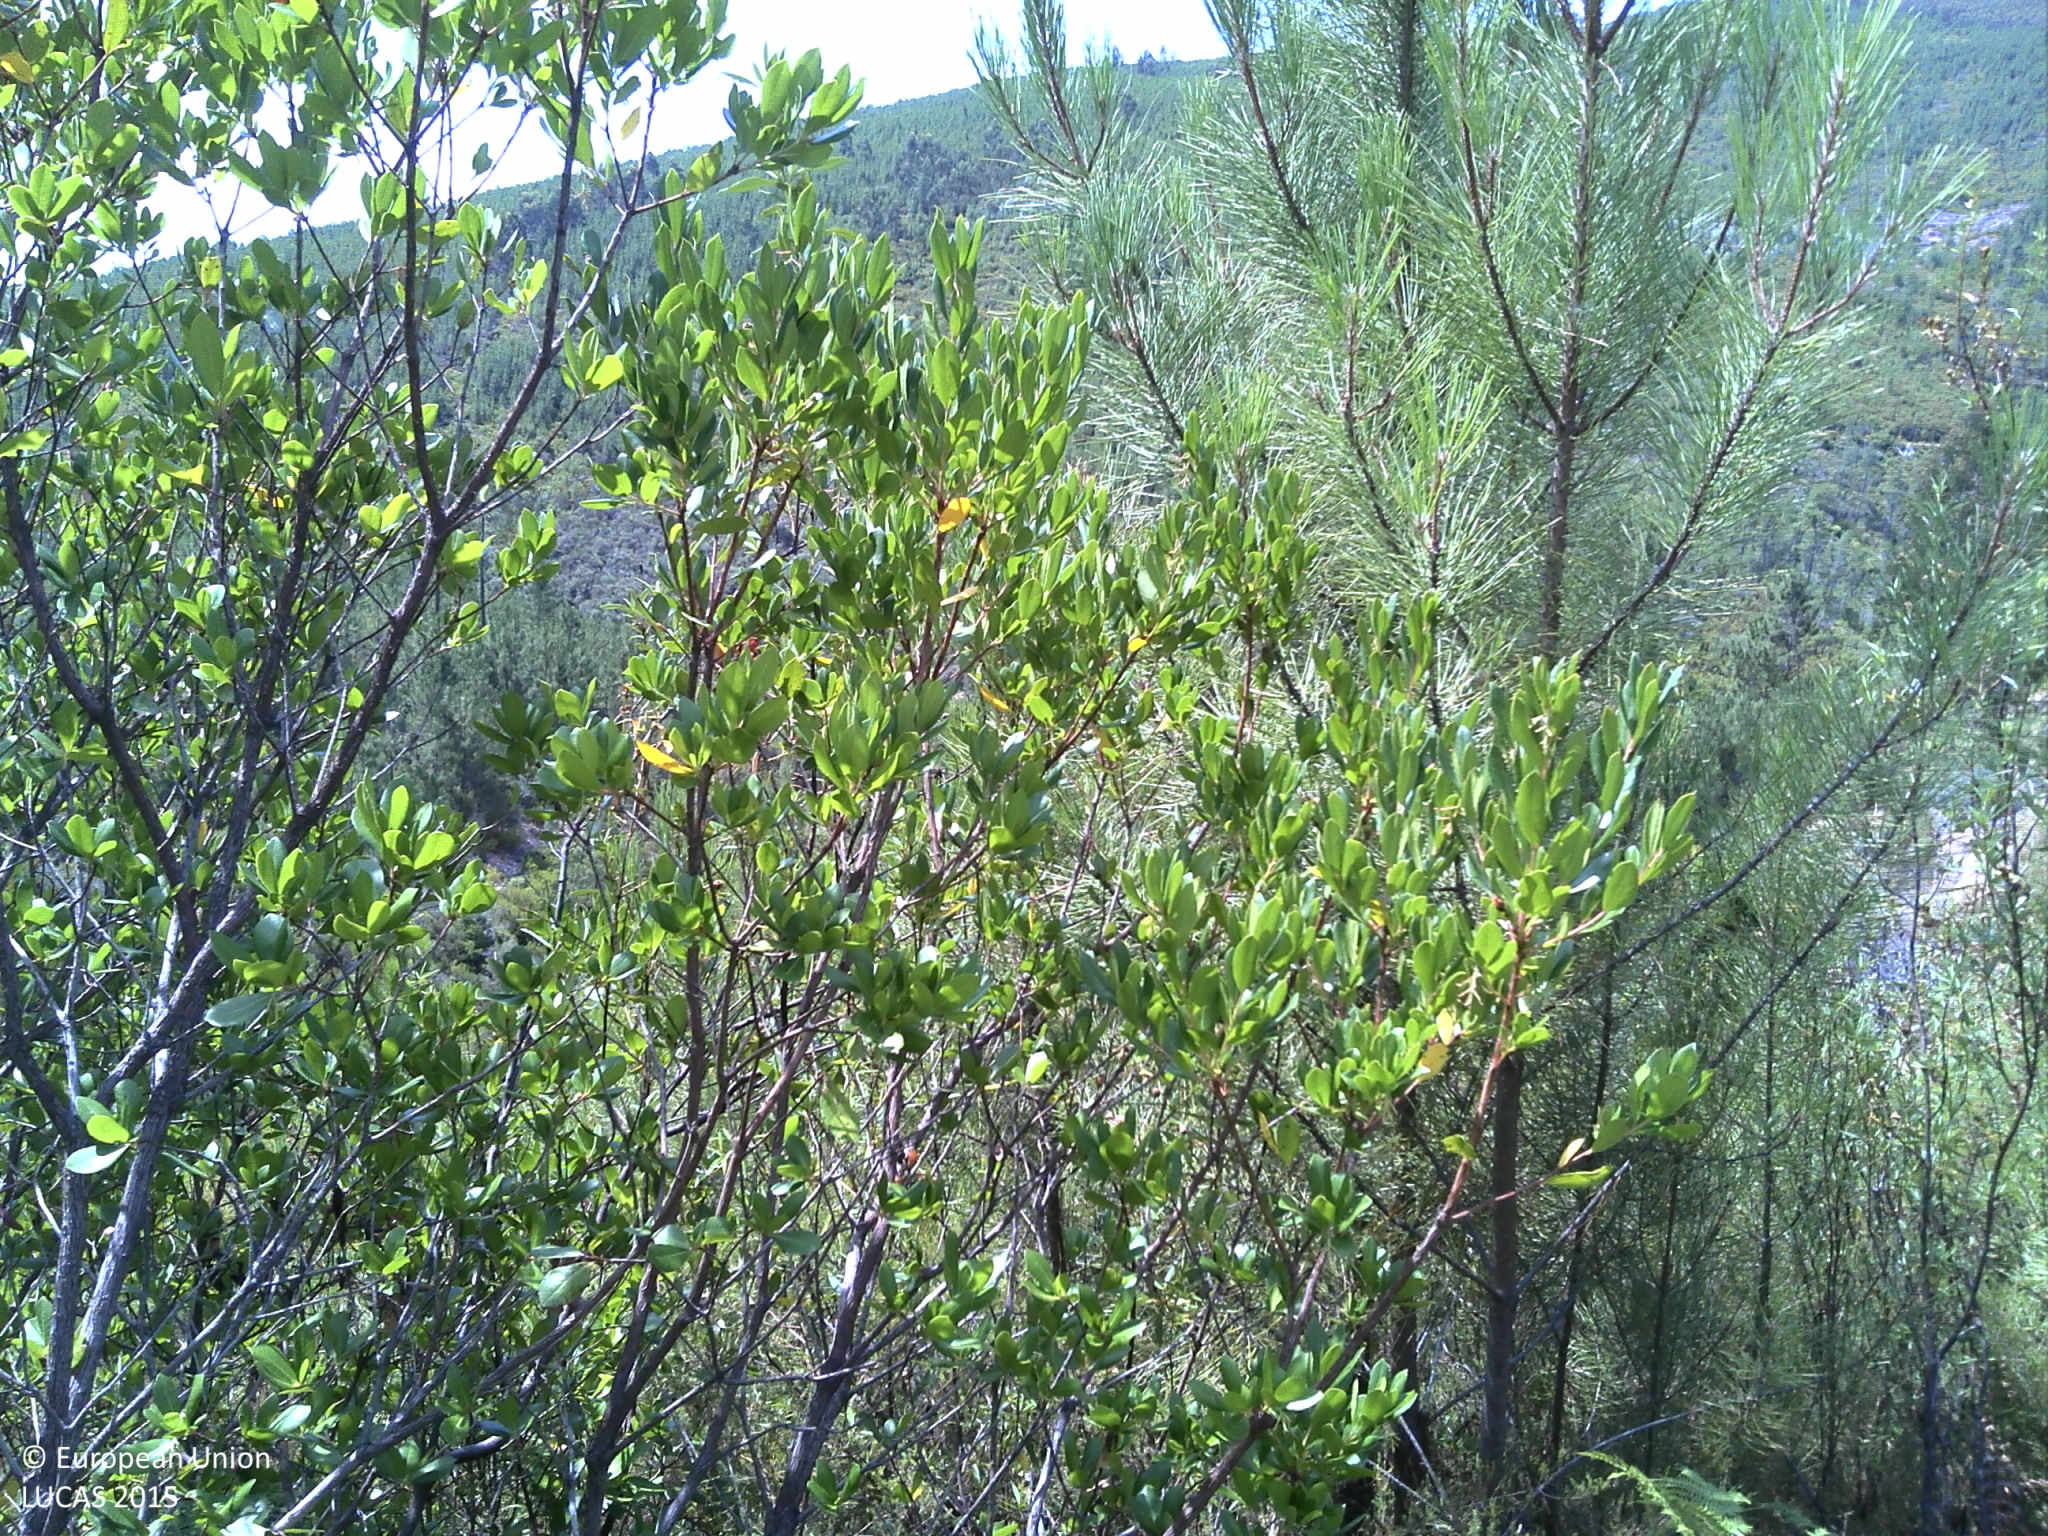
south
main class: Woodland
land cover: Pine dominated coniferous woodland
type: coniferous forest of the mediterranean region
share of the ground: 25 - 50 %
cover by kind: shrubs 50 %, coniferous forest trees 30 %, unconsolidated bare surface 20 %
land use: Forestry
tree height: < 5 m
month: July
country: PT
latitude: 39.8417
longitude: -7.8121
